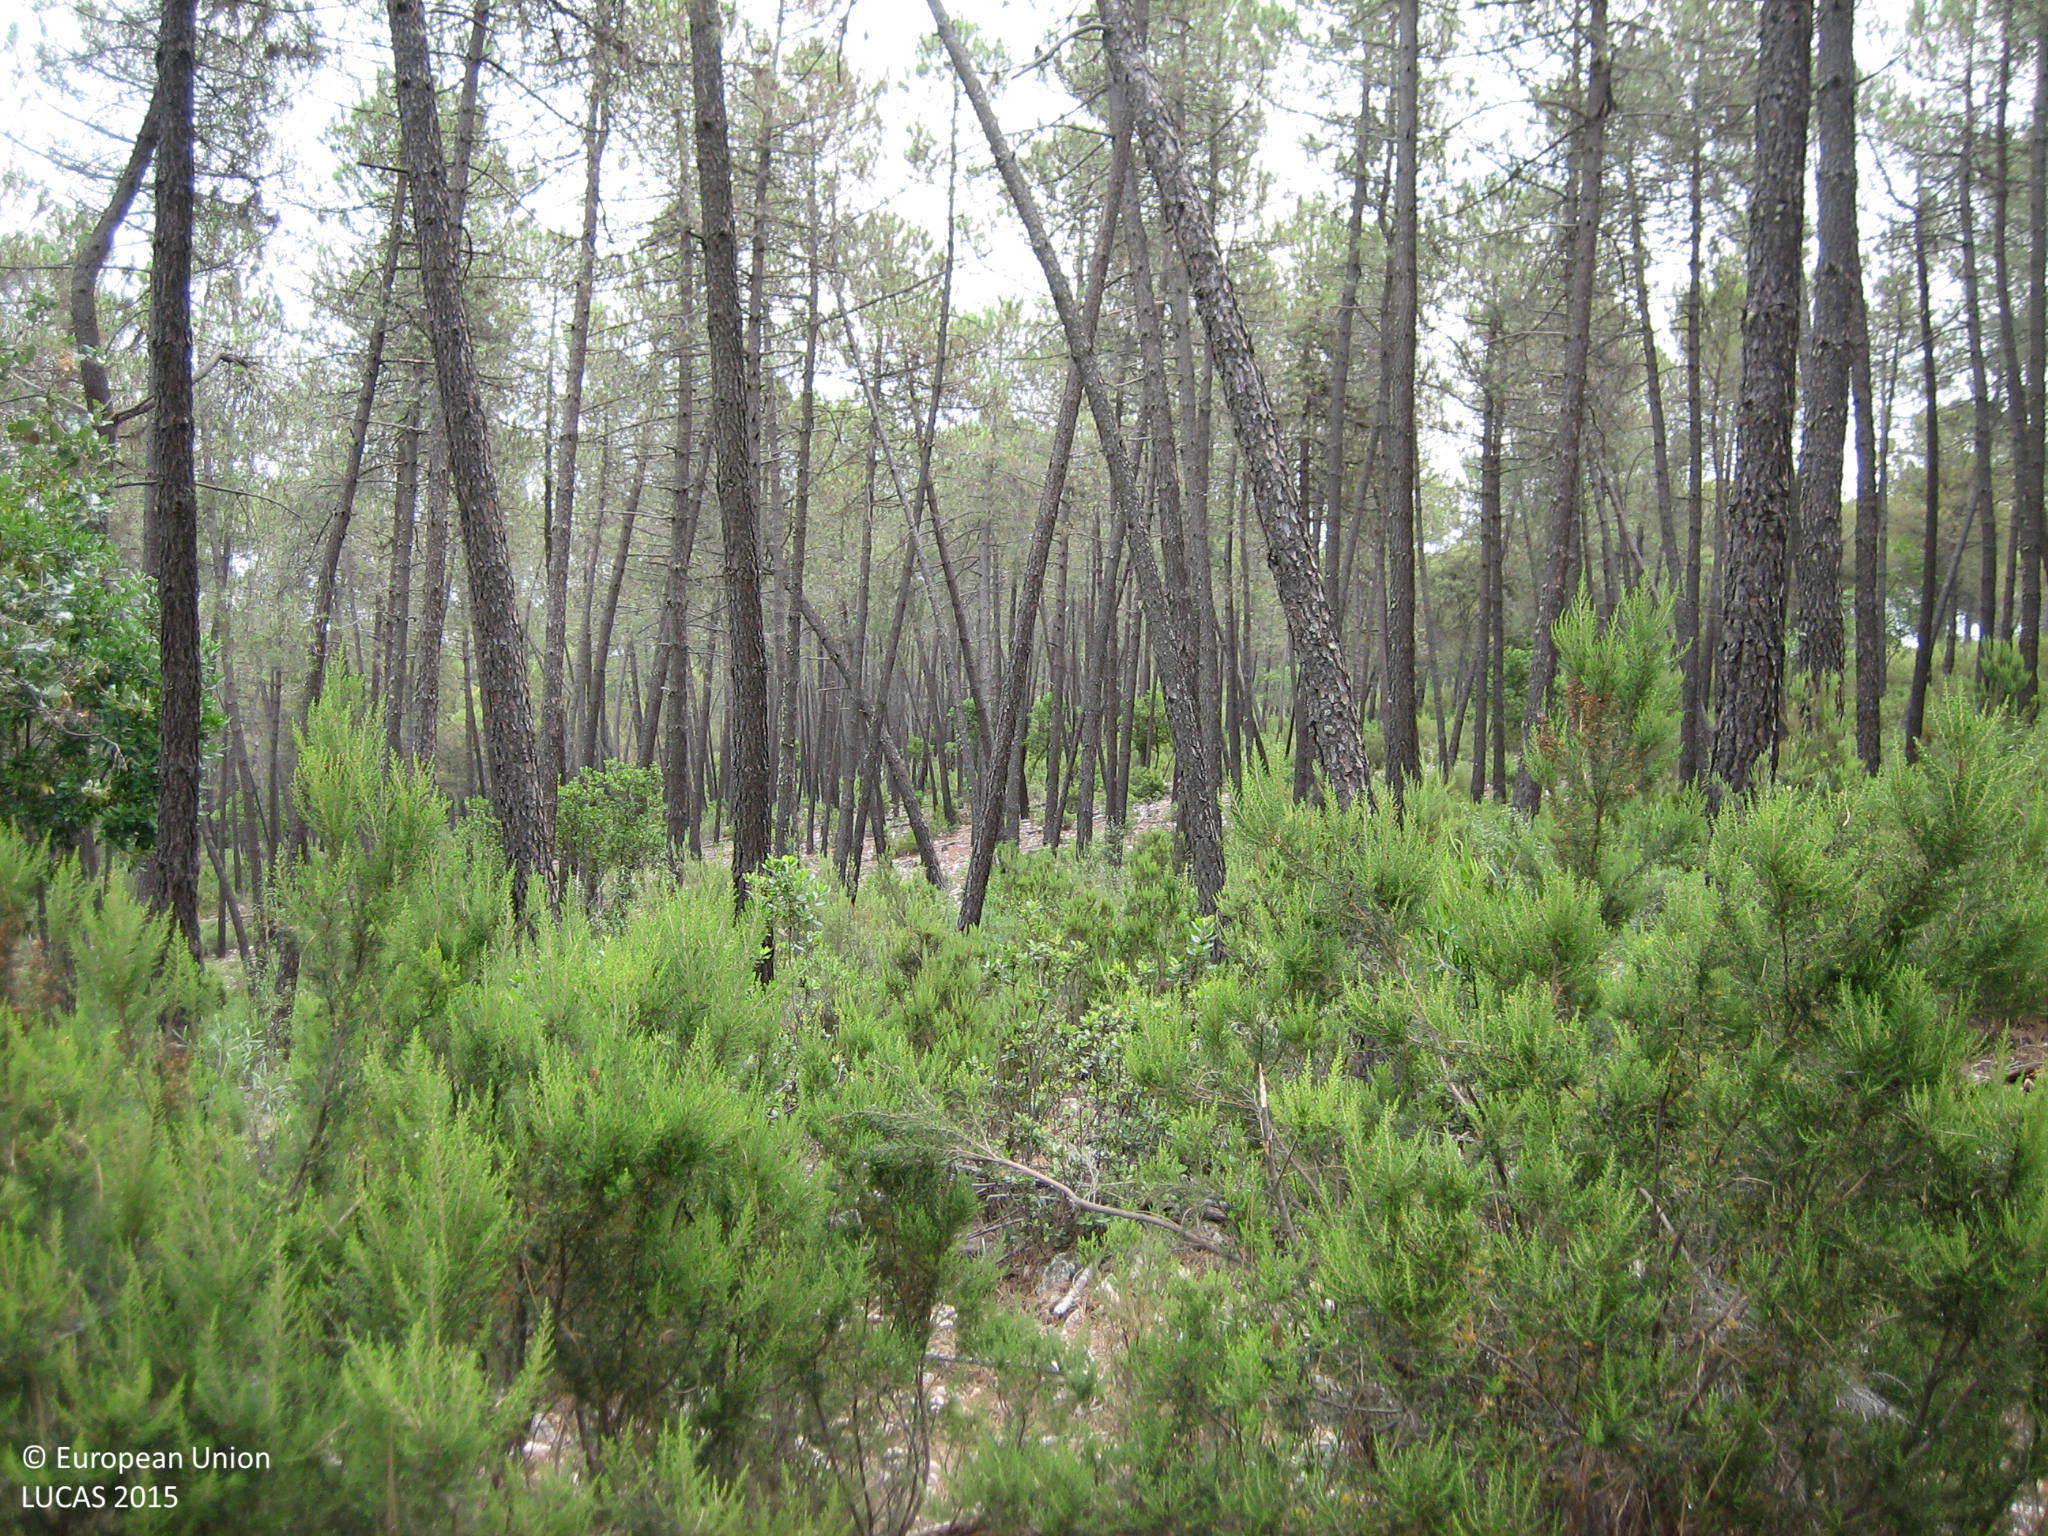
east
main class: Woodland
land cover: Pine dominated coniferous woodland
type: coniferous forest of the mediterranean region
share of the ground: > 75 %
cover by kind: coniferous forest trees 90 %, shrubs 10 %
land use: Forestry
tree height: > 5 m
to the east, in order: Pine dominated coniferous woodland
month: June
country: ES
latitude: 39.2890
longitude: -4.7727
